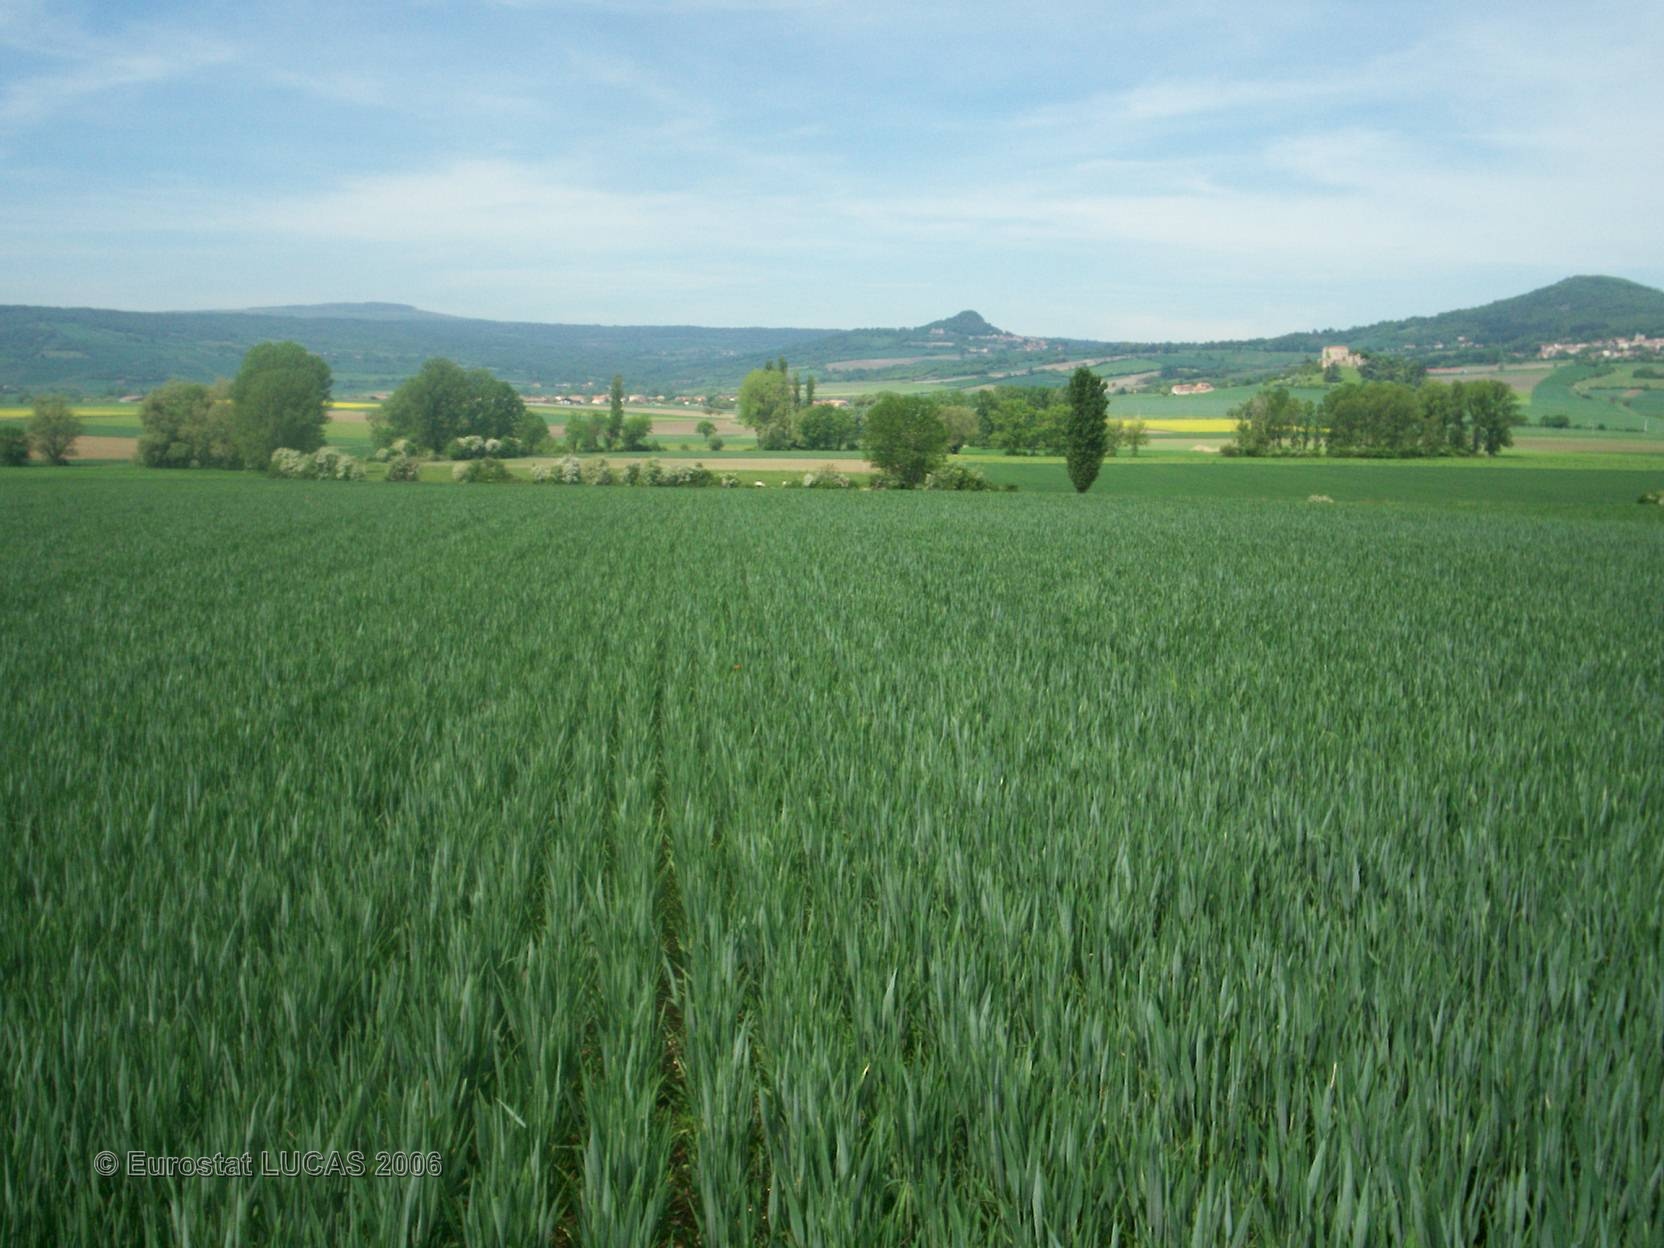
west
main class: Cropland
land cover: Common wheat
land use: Agriculture (excluding fallow land and kitchen gardens)
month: May
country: FR
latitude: 45.5024
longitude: 3.2051
